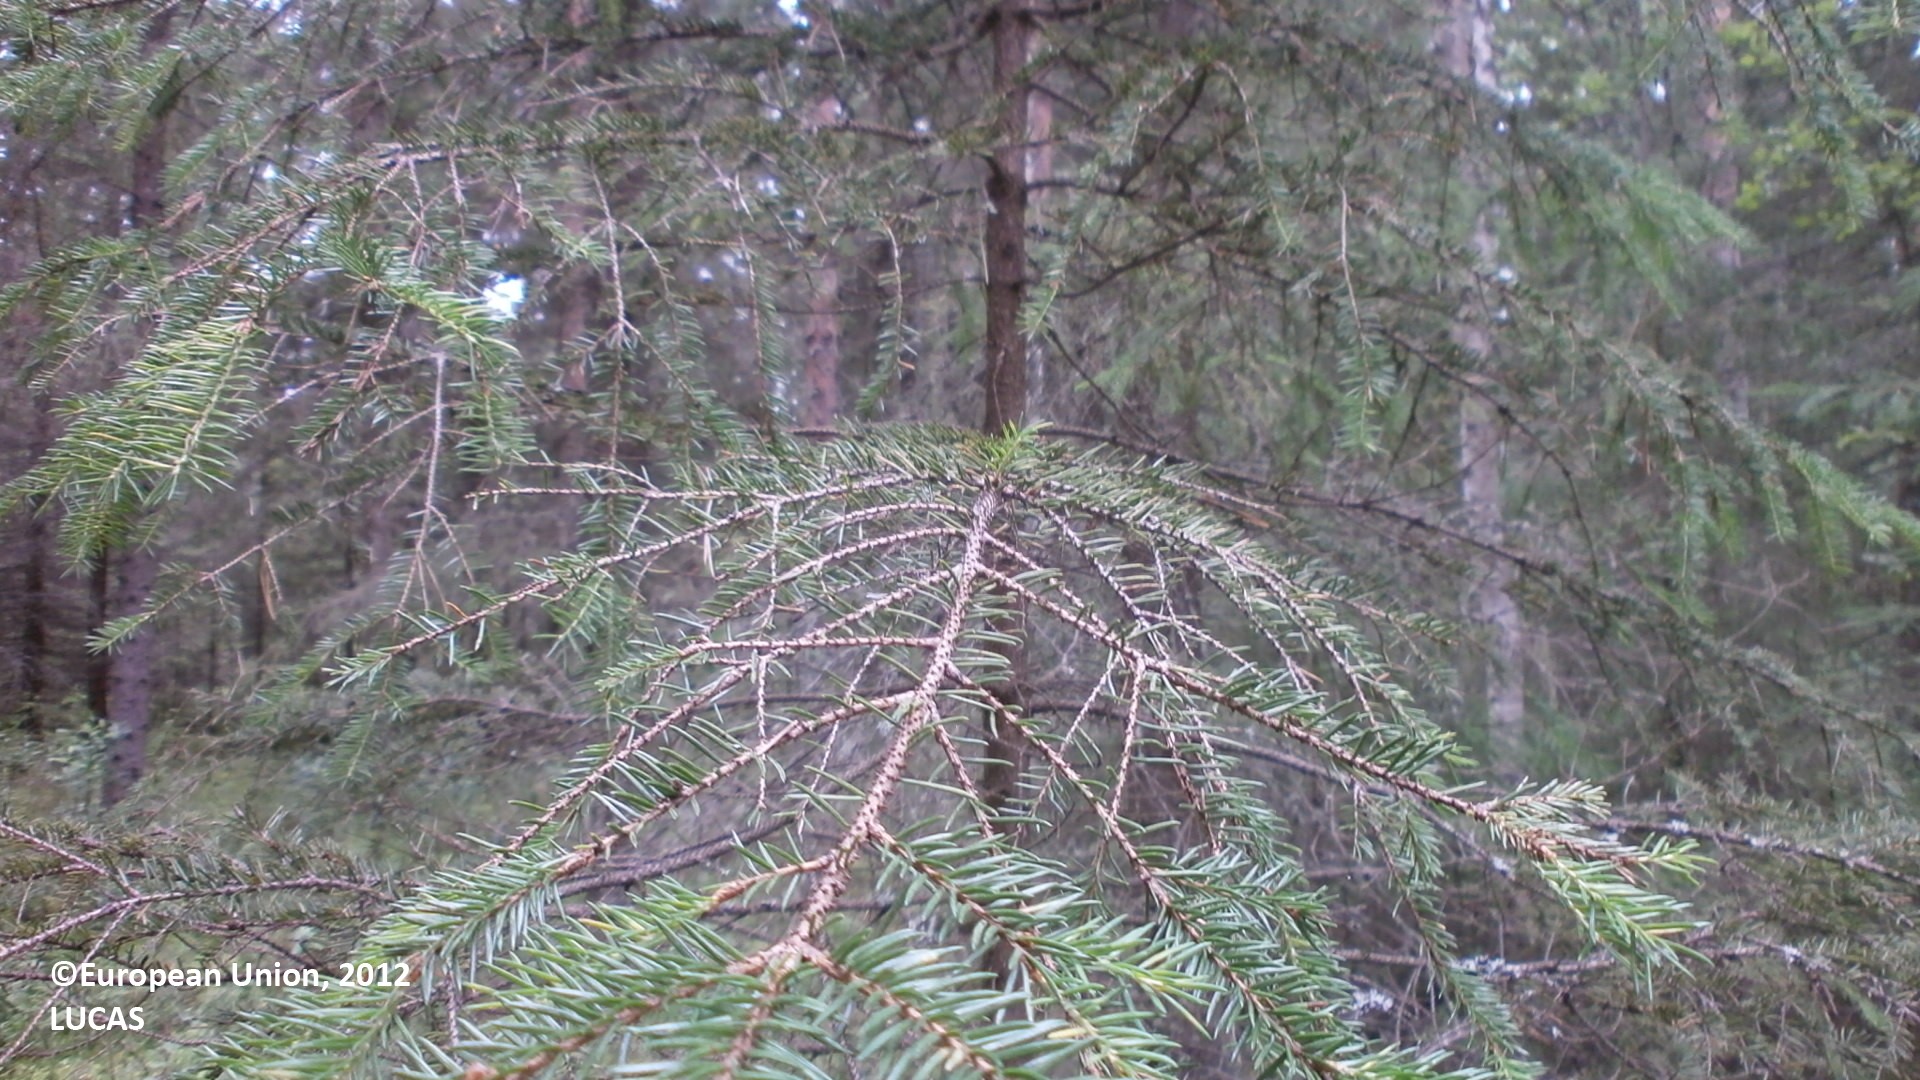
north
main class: Woodland
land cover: Spruce dominated mixed woodland
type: boreal forest
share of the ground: > 75 %
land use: Forestry
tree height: > 5 m
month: July
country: FI
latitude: 64.2137
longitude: 24.2215
